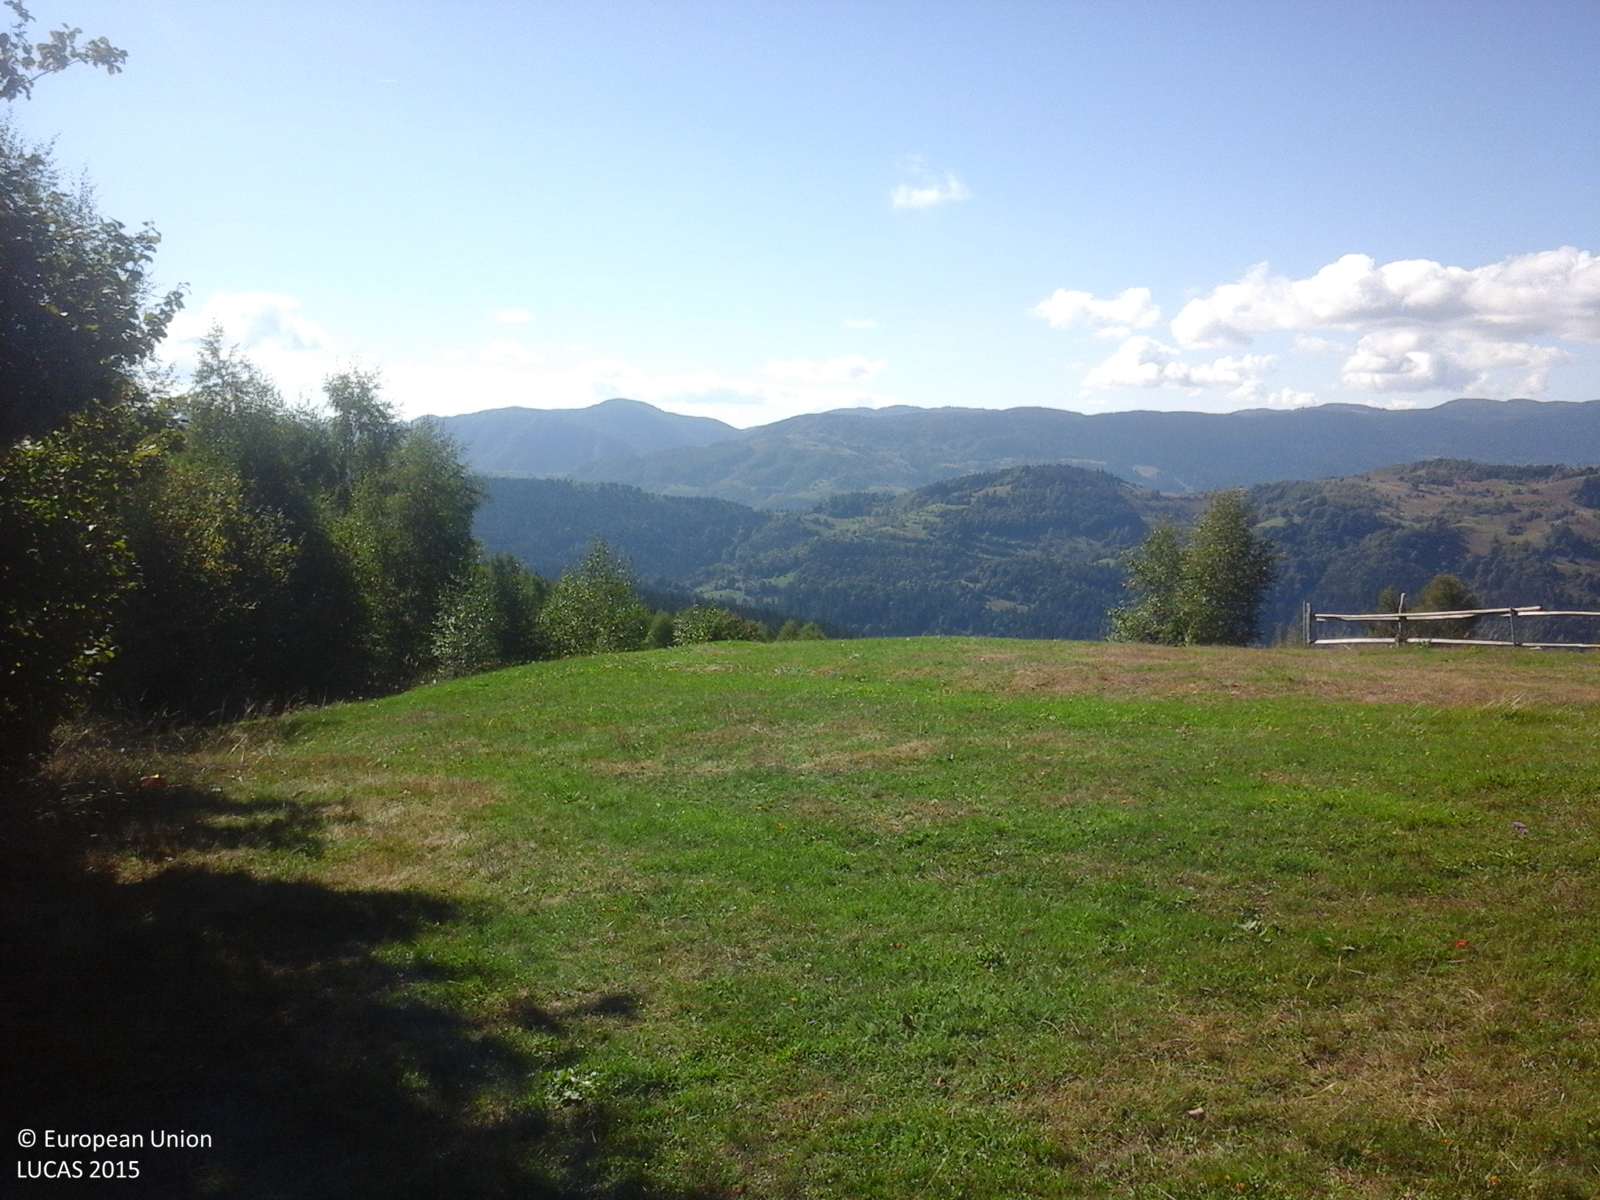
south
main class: Cropland
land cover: Apple fruit
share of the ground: > 75 %
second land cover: Grassland without tree/shrub cover
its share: > 75 %
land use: Agriculture (excluding fallow land and kitchen gardens)
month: October
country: RO
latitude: 46.4168
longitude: 22.9513
